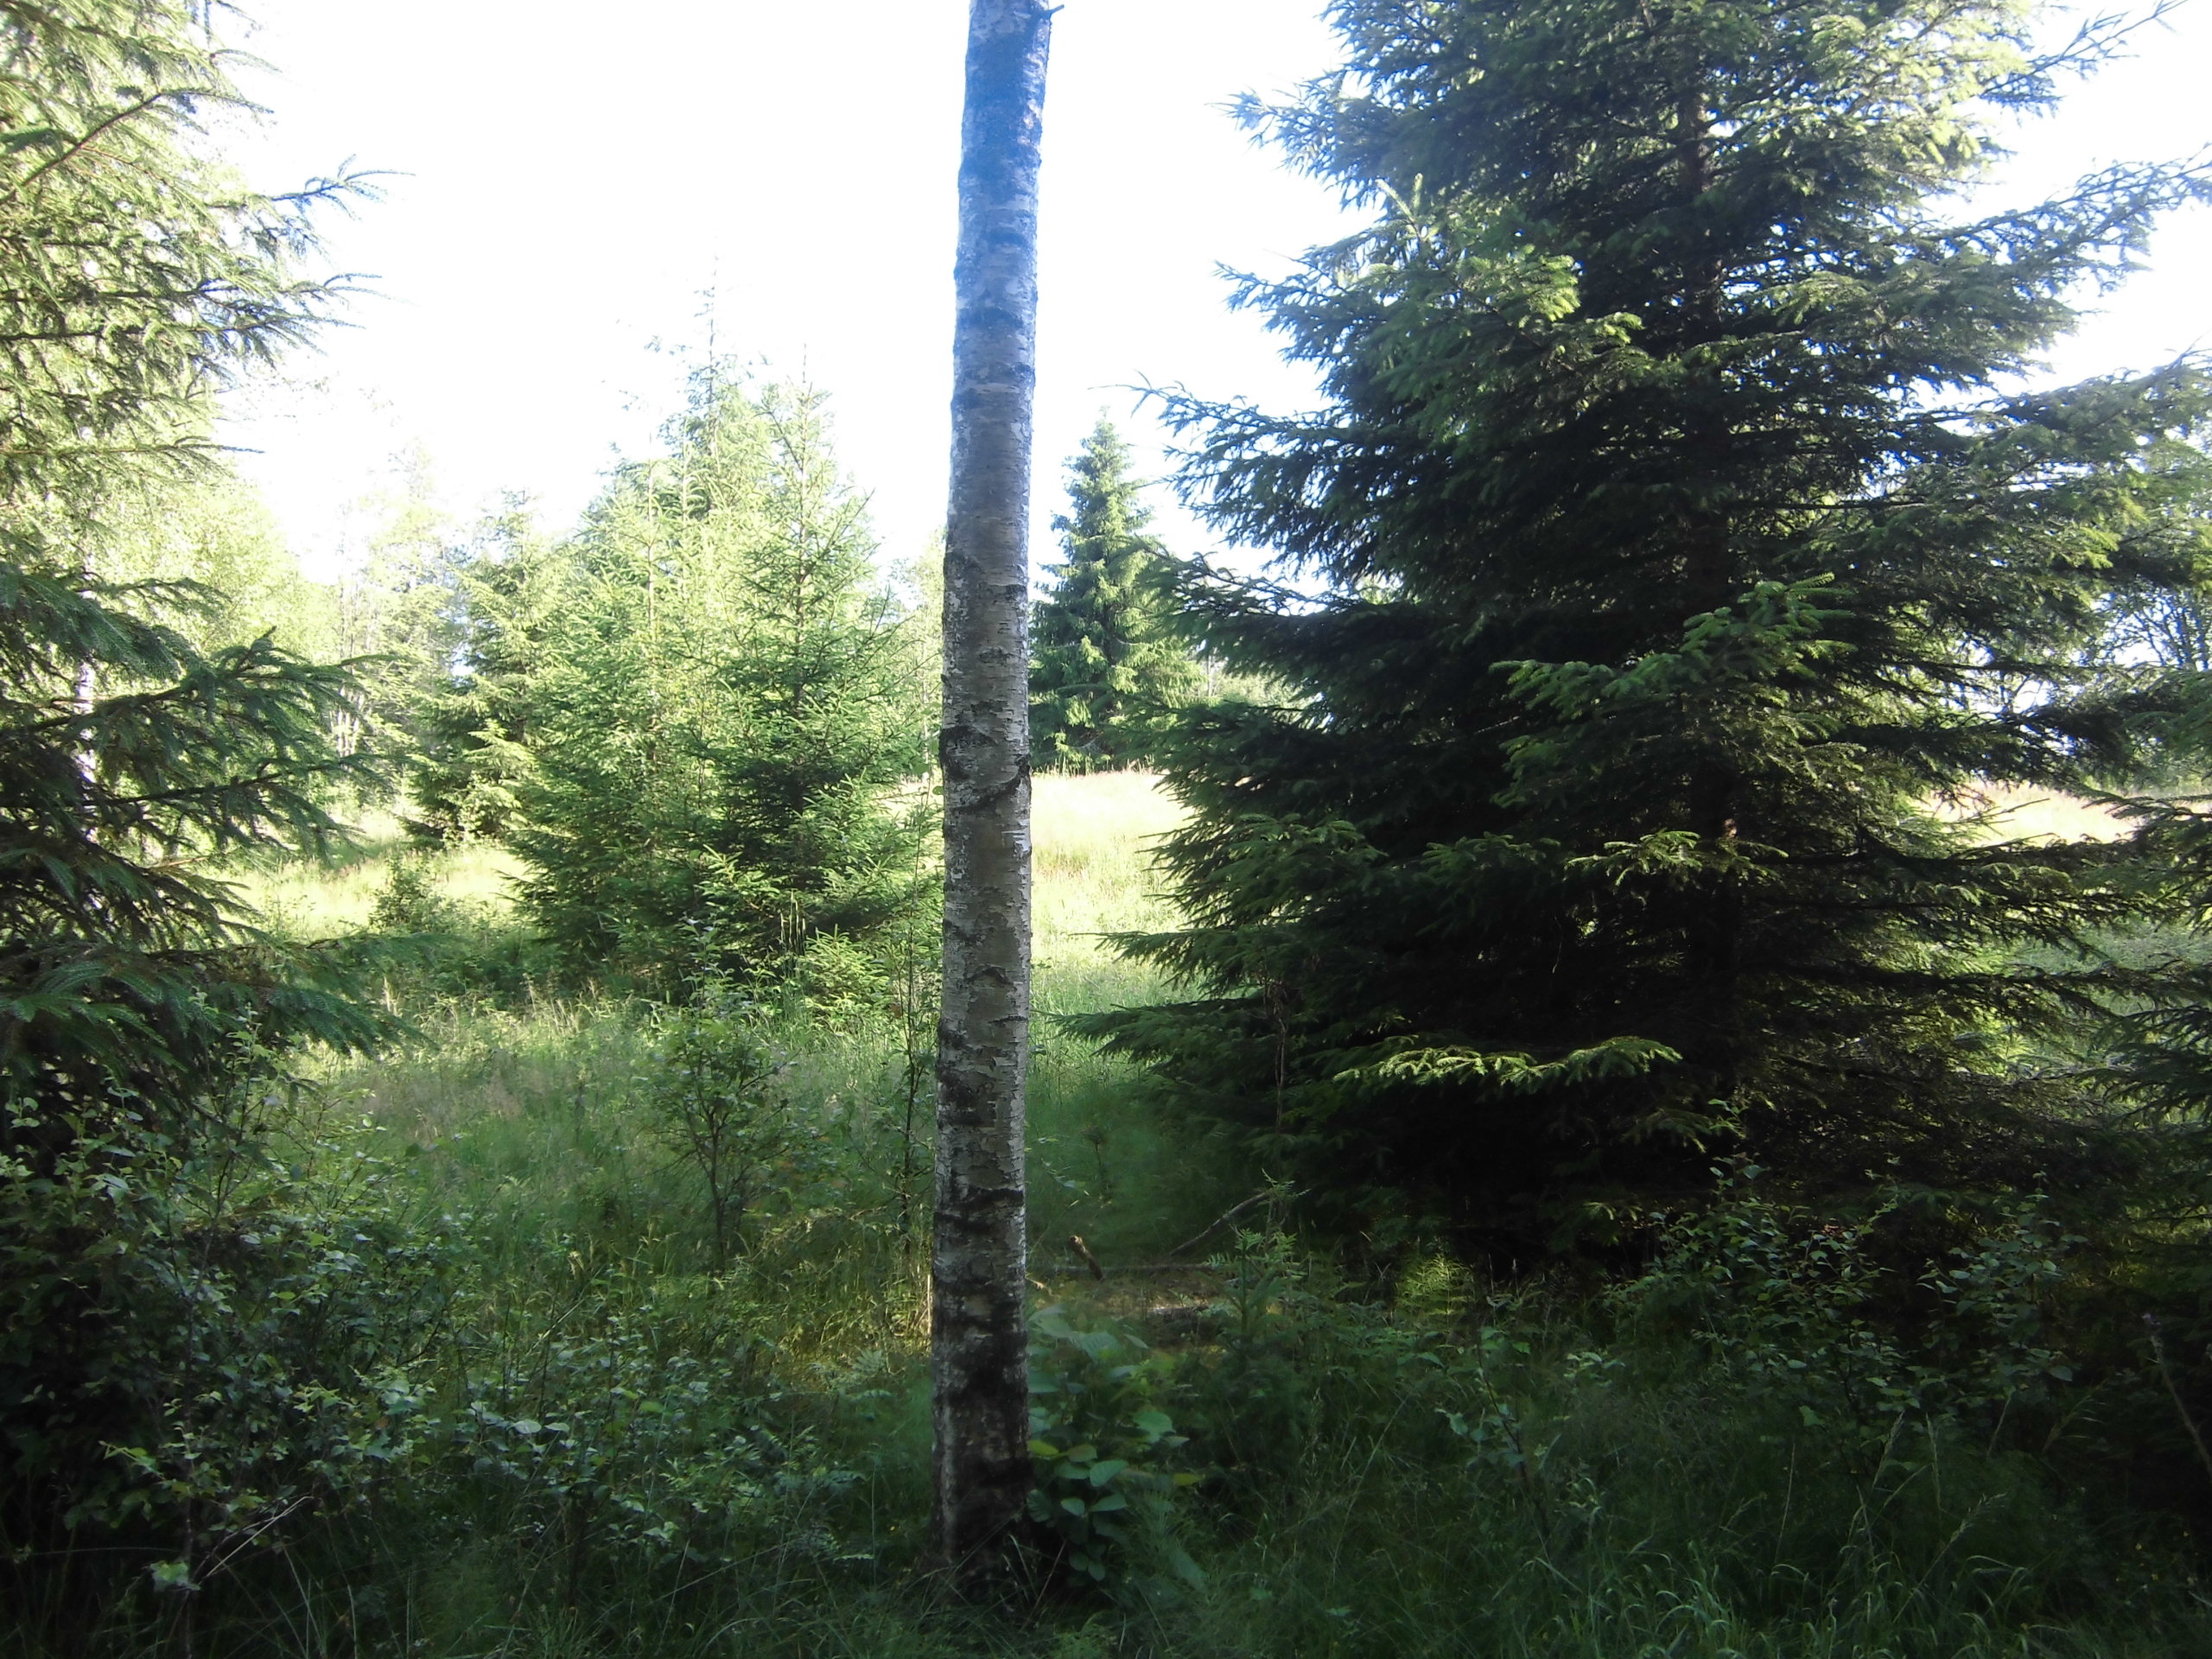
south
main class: Woodland
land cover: Spruce dominated mixed woodland
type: boreal forest
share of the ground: 50 - 75 %
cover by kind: broadleaved forest trees 35 %, herbaceous plants 30 %, coniferous forest trees 25 %, shrubs 5 %, lichens and mosses 5 %
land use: Forestry
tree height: > 5 m
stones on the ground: < 10 %
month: July
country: SE
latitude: 57.1966
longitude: 15.2766
